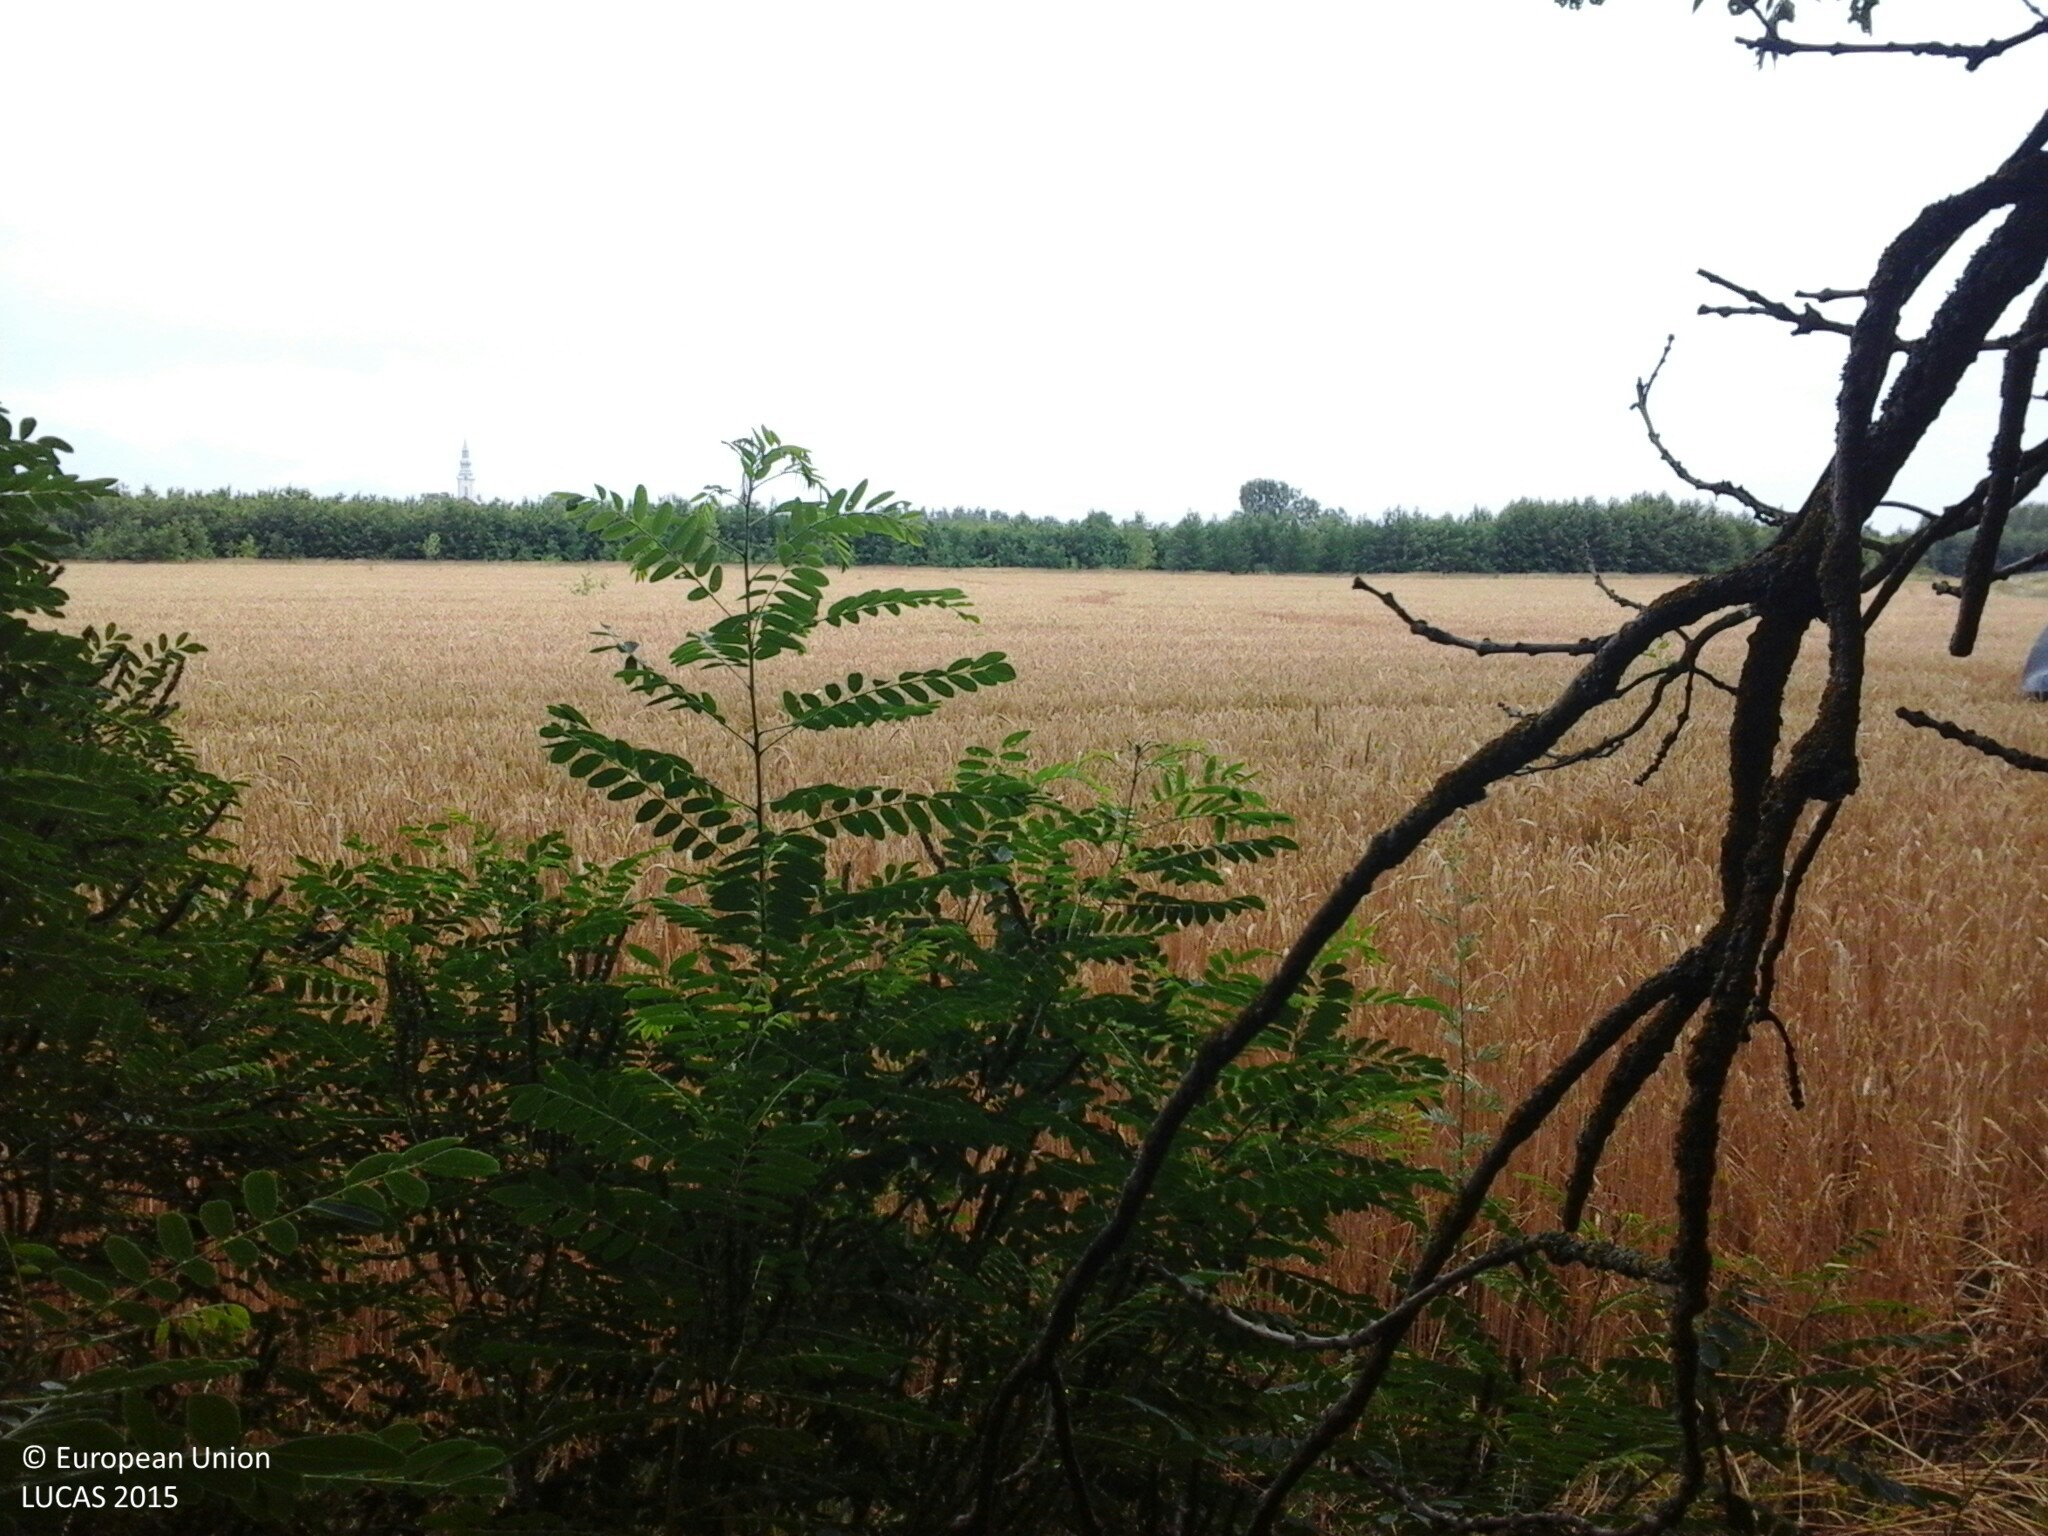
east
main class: Woodland
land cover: Broadleaved woodland
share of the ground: > 75 %
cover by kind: broadleaved forest trees 100 %
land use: Forestry
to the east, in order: Broadleaved woodland; Triticale; Abandoned hedges; Triticale; Grassland without tree/shrub cover; Broadleaved woodland
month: July
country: HU
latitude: 48.3390
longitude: 21.9108
